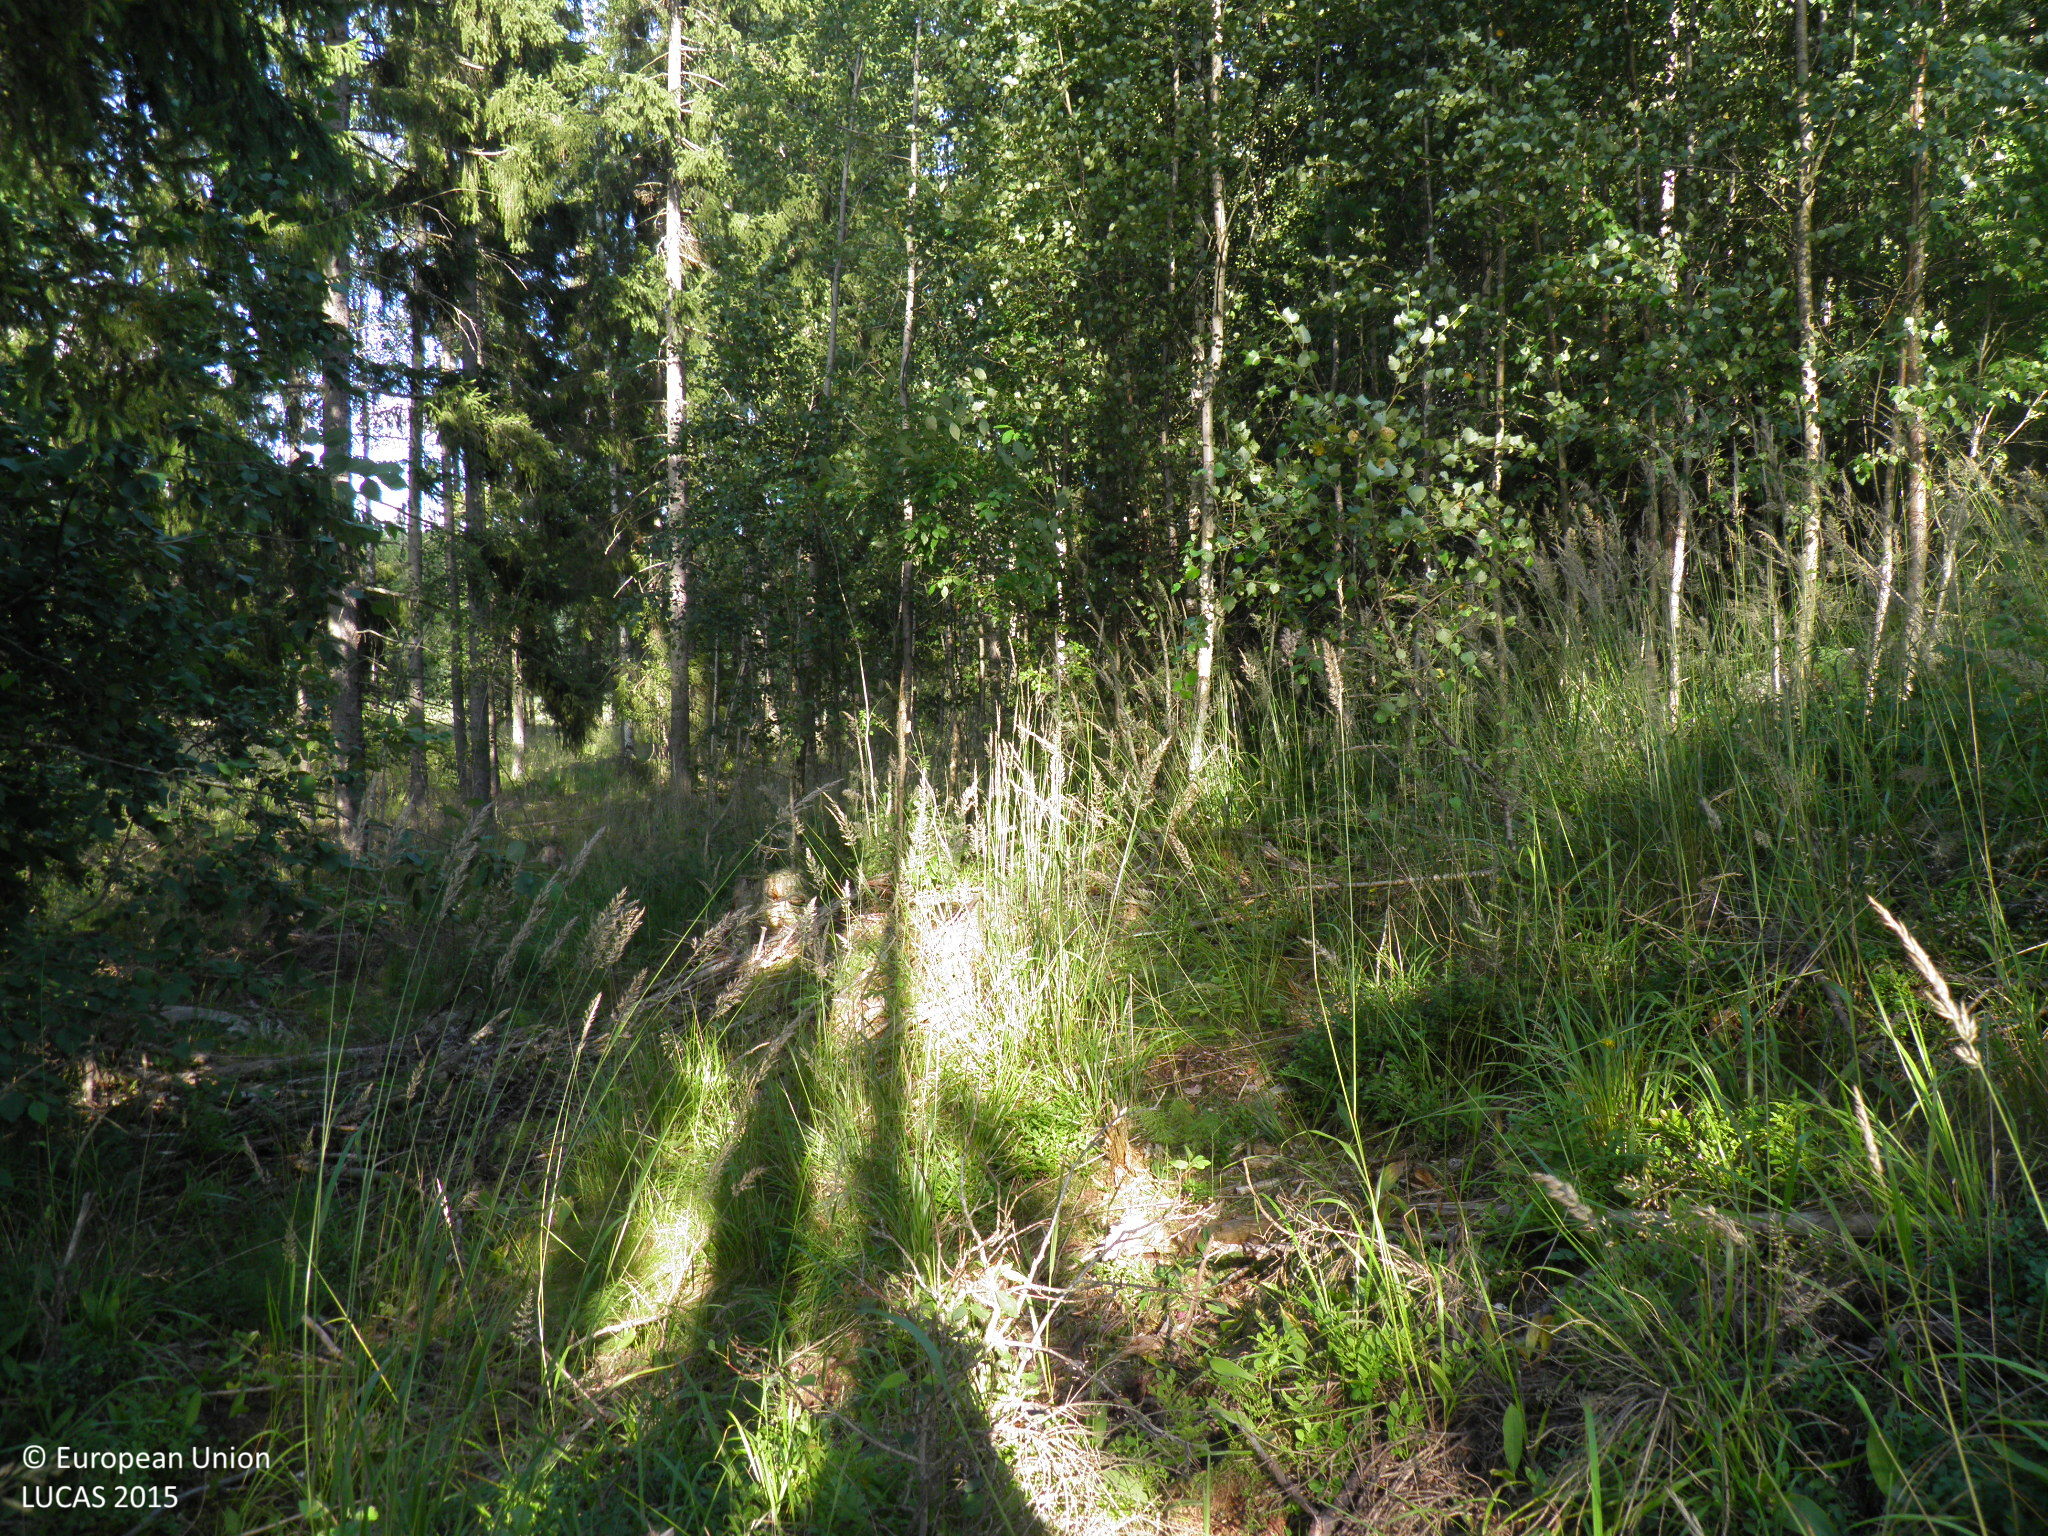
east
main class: Woodland
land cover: Spruce dominated coniferous woodland
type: hemiboreal forest and nemoral coniferous forest and mixed broadleaved-coniferous forest
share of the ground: 25 - 50 %
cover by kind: coniferous forest trees 30 %, herbaceous plants 30 %, shrubs 20 %, broadleaved forest trees 10 %, lichens and mosses 10 %
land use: Forestry
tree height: > 5 m
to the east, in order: Spruce dominated coniferous woodland; Broadleaved woodland; Spruce dominated mixed woodland; Ditches and canals; Electric lines; Barley
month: August
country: FI
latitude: 61.0231
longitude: 22.9715
